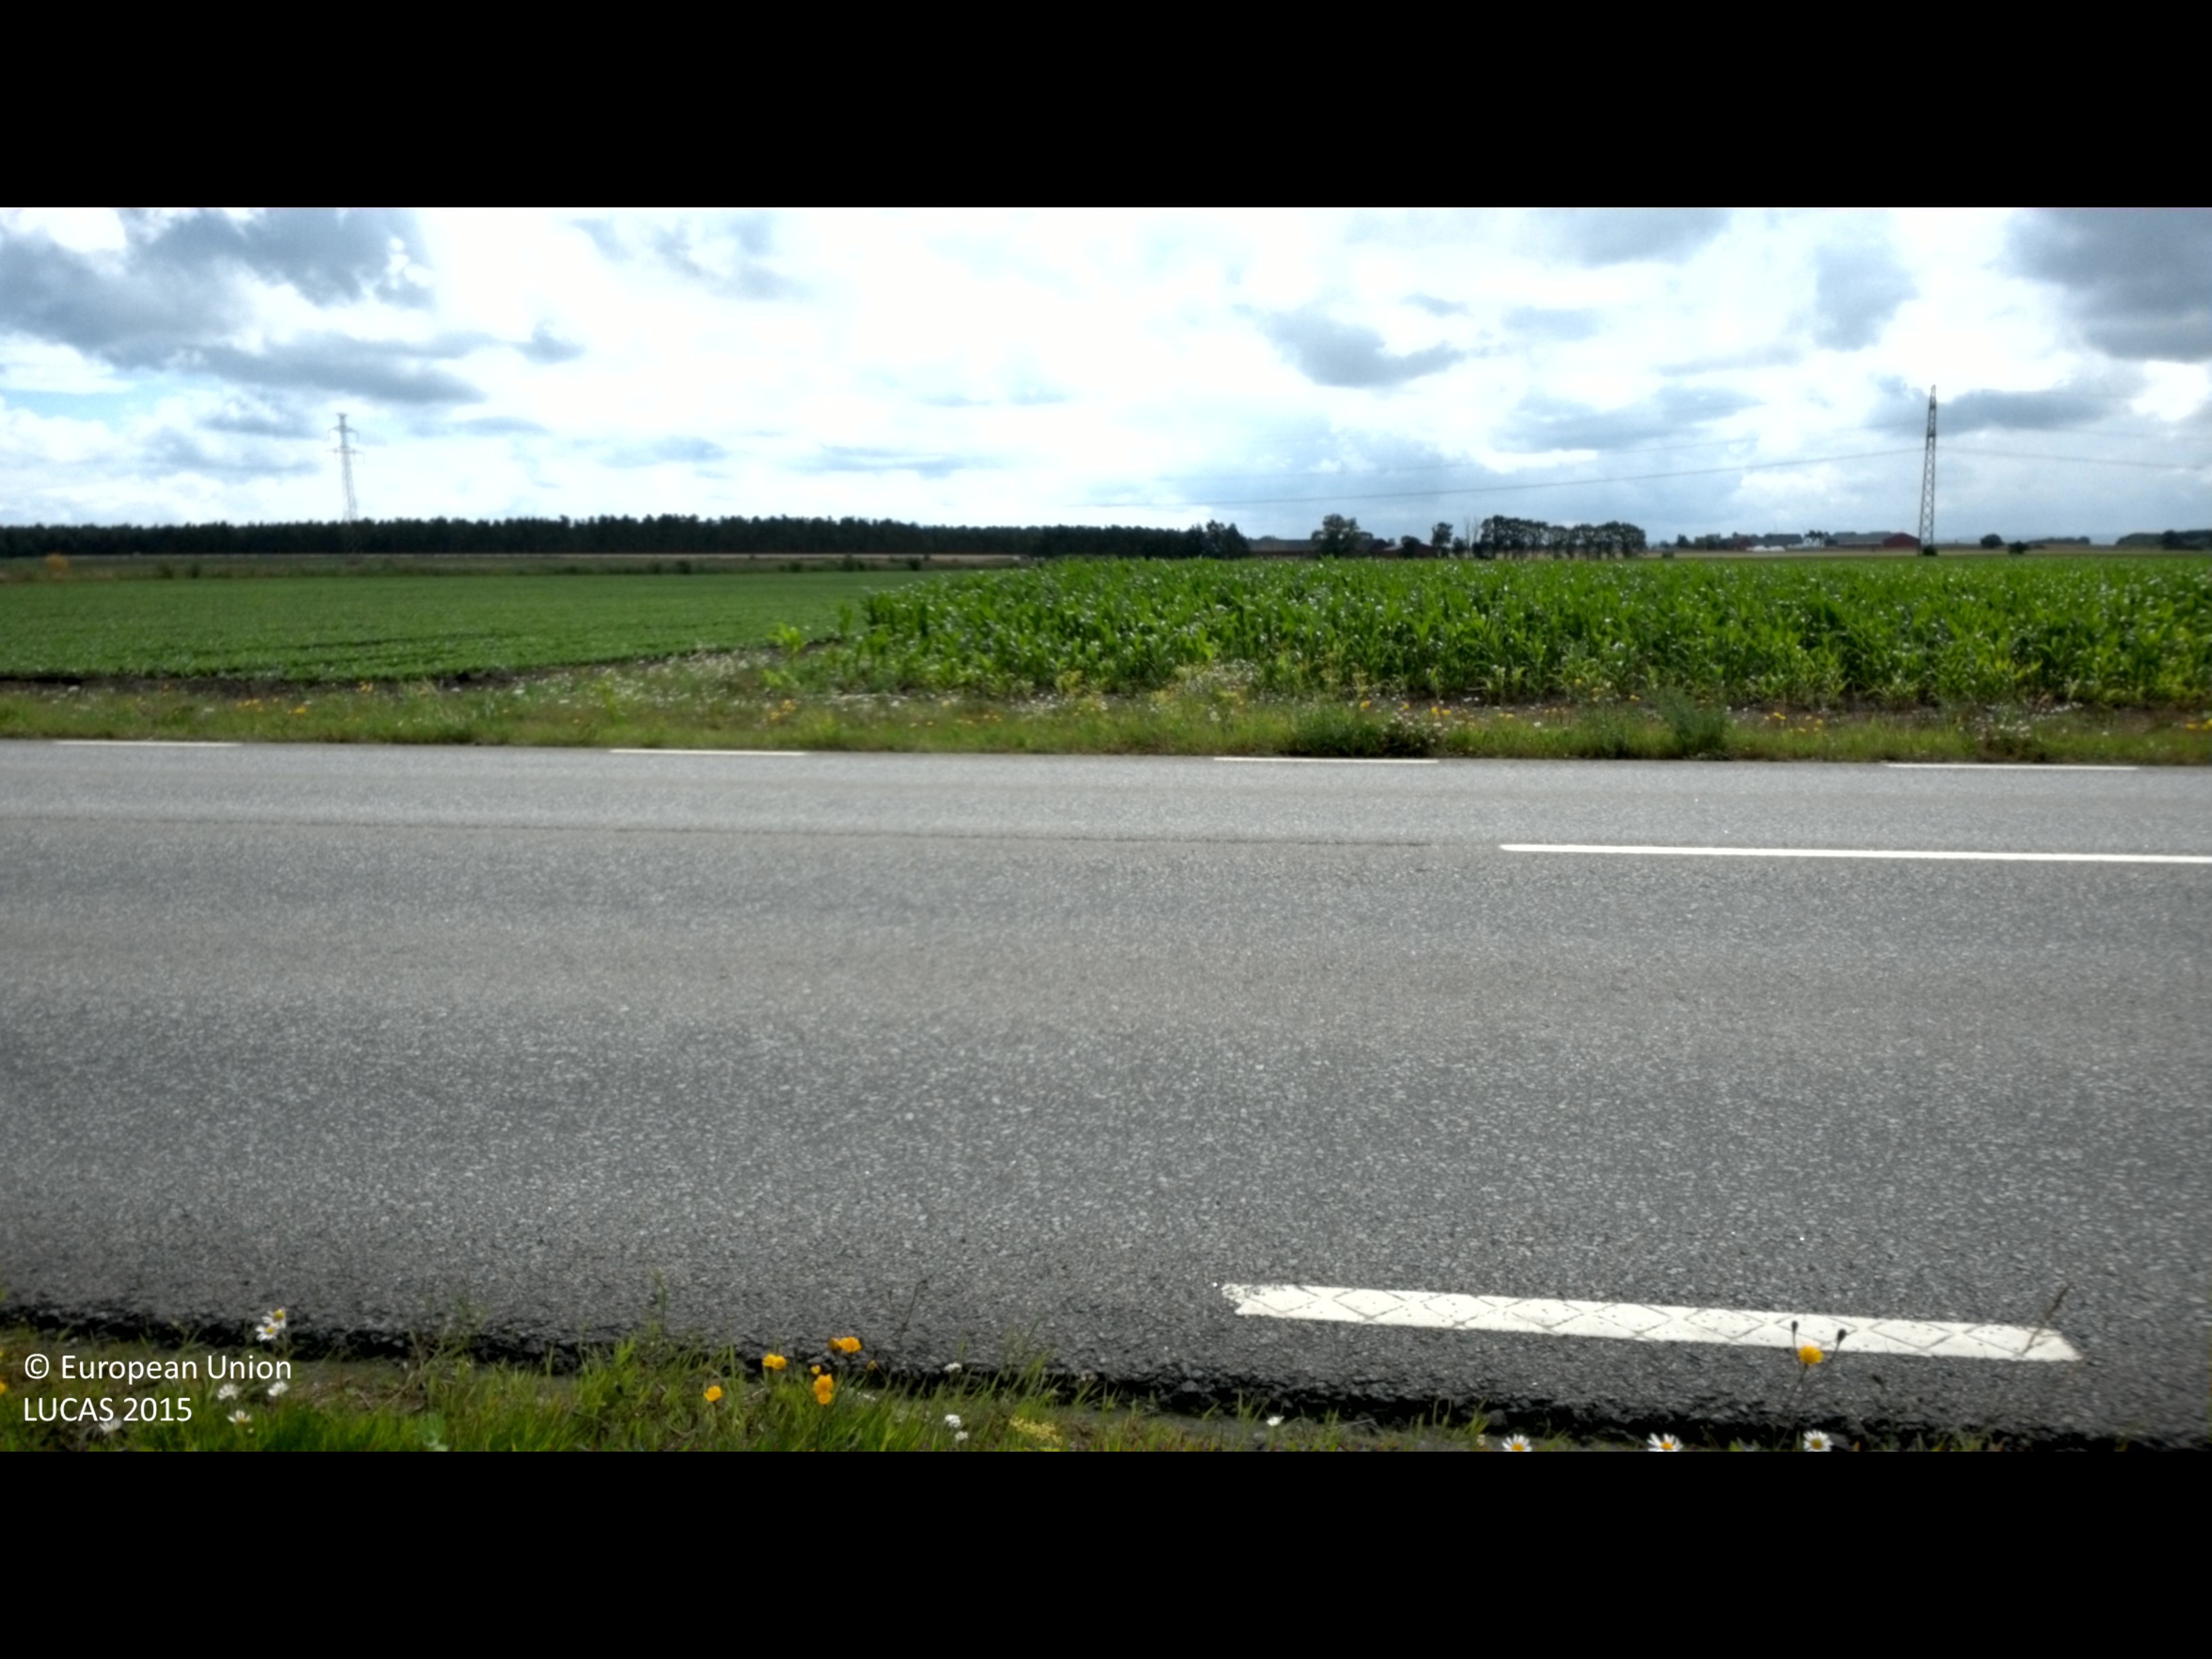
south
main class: Cropland
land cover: Common wheat
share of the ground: > 75 %
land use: Agriculture (excluding fallow land and kitchen gardens)
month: July
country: SE
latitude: 55.9377
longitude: 14.2405
